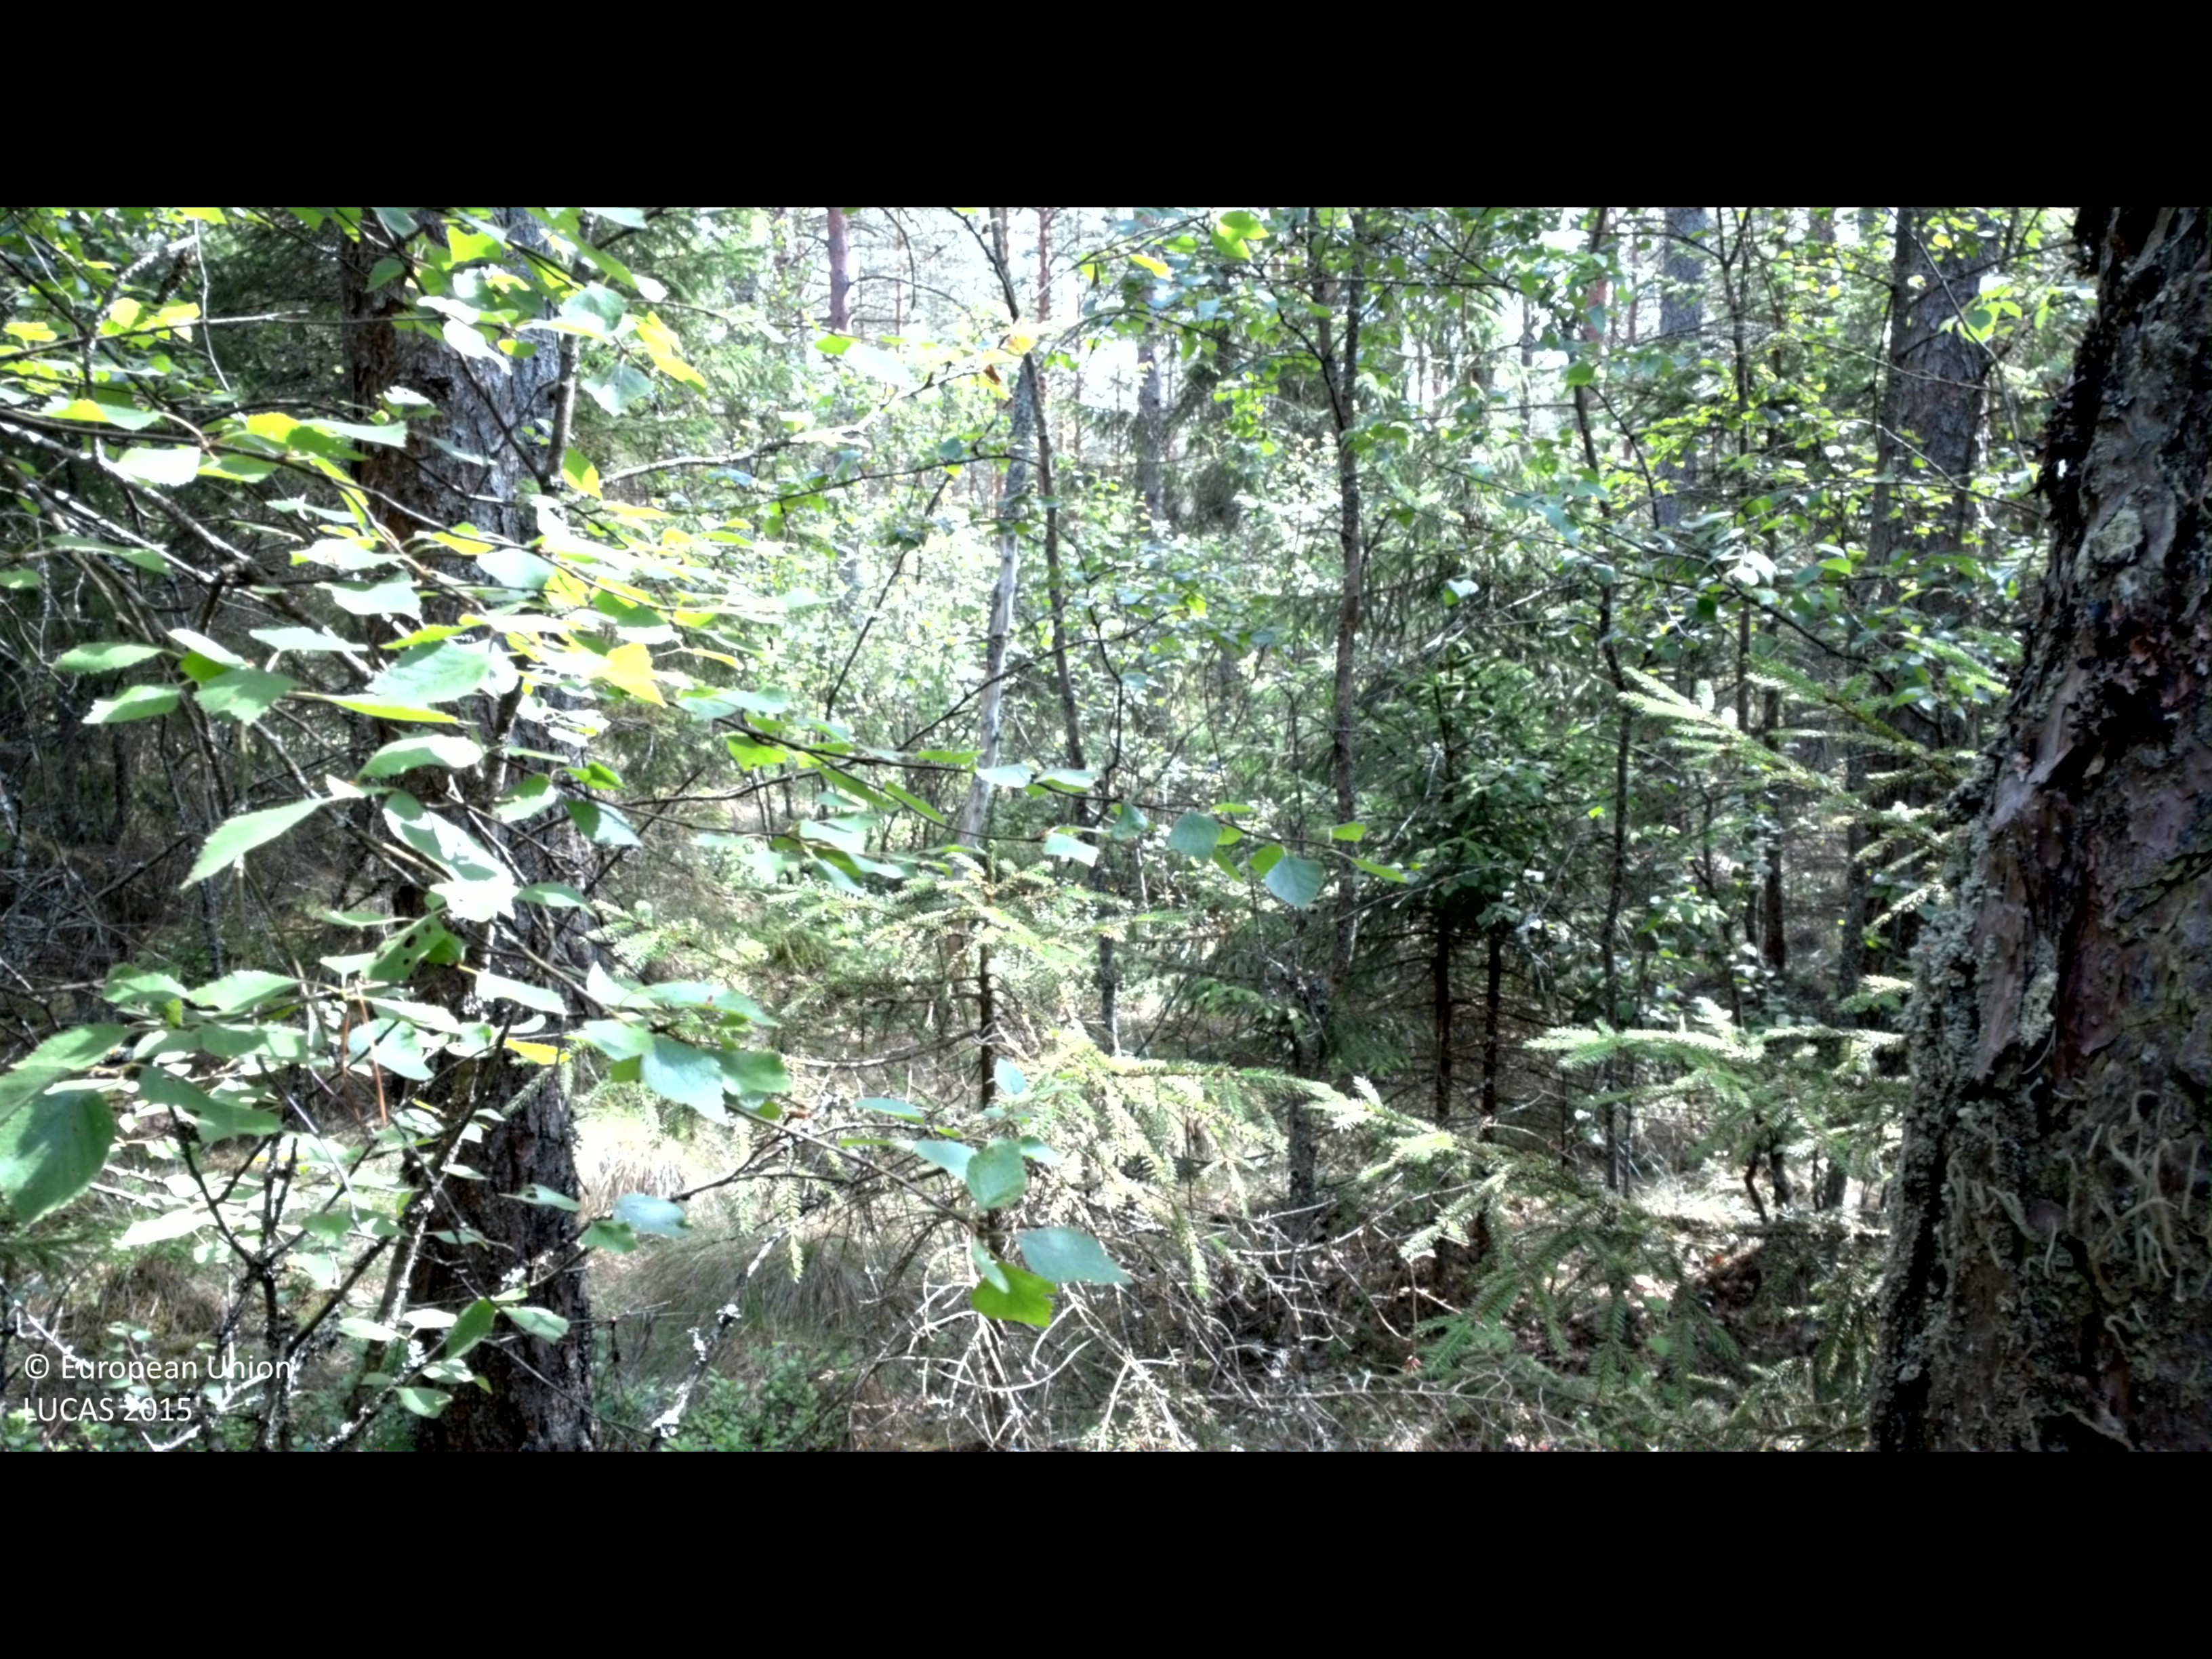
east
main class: Woodland
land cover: Other mixed woodland
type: boreal forest
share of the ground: > 75 %
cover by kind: coniferous forest trees 50 %, broadleaved forest trees 30 %, shrubs 15 %, lichens and mosses 5 %
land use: Forestry
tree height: > 5 m
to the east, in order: Other mixed woodland; Ditches and canals; Spruce dominated coniferous woodland
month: July
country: SE
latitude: 56.4357
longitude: 14.4250
